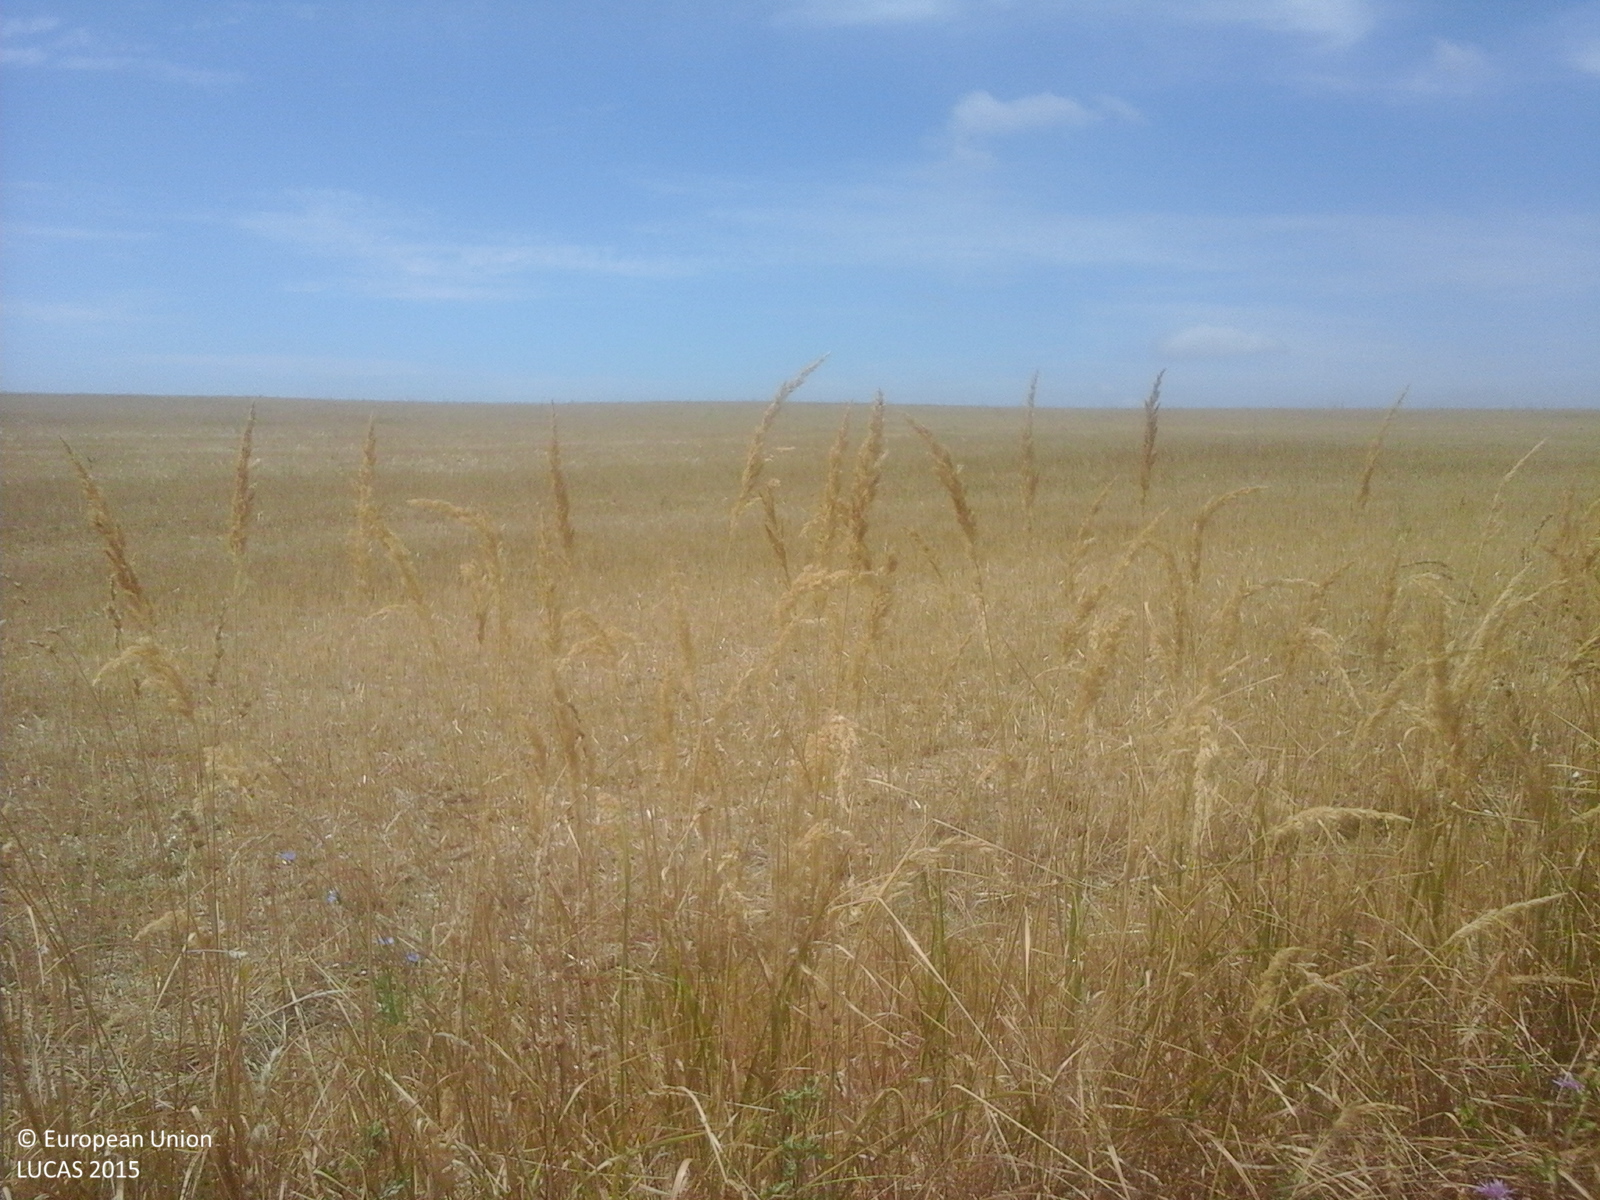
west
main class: Grassland
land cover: Spontaneously vegetated surfaces
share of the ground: > 75 %
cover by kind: herbaceous plants 100 %
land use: Fallow land
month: August
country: RO
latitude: 44.9205
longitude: 21.5704
